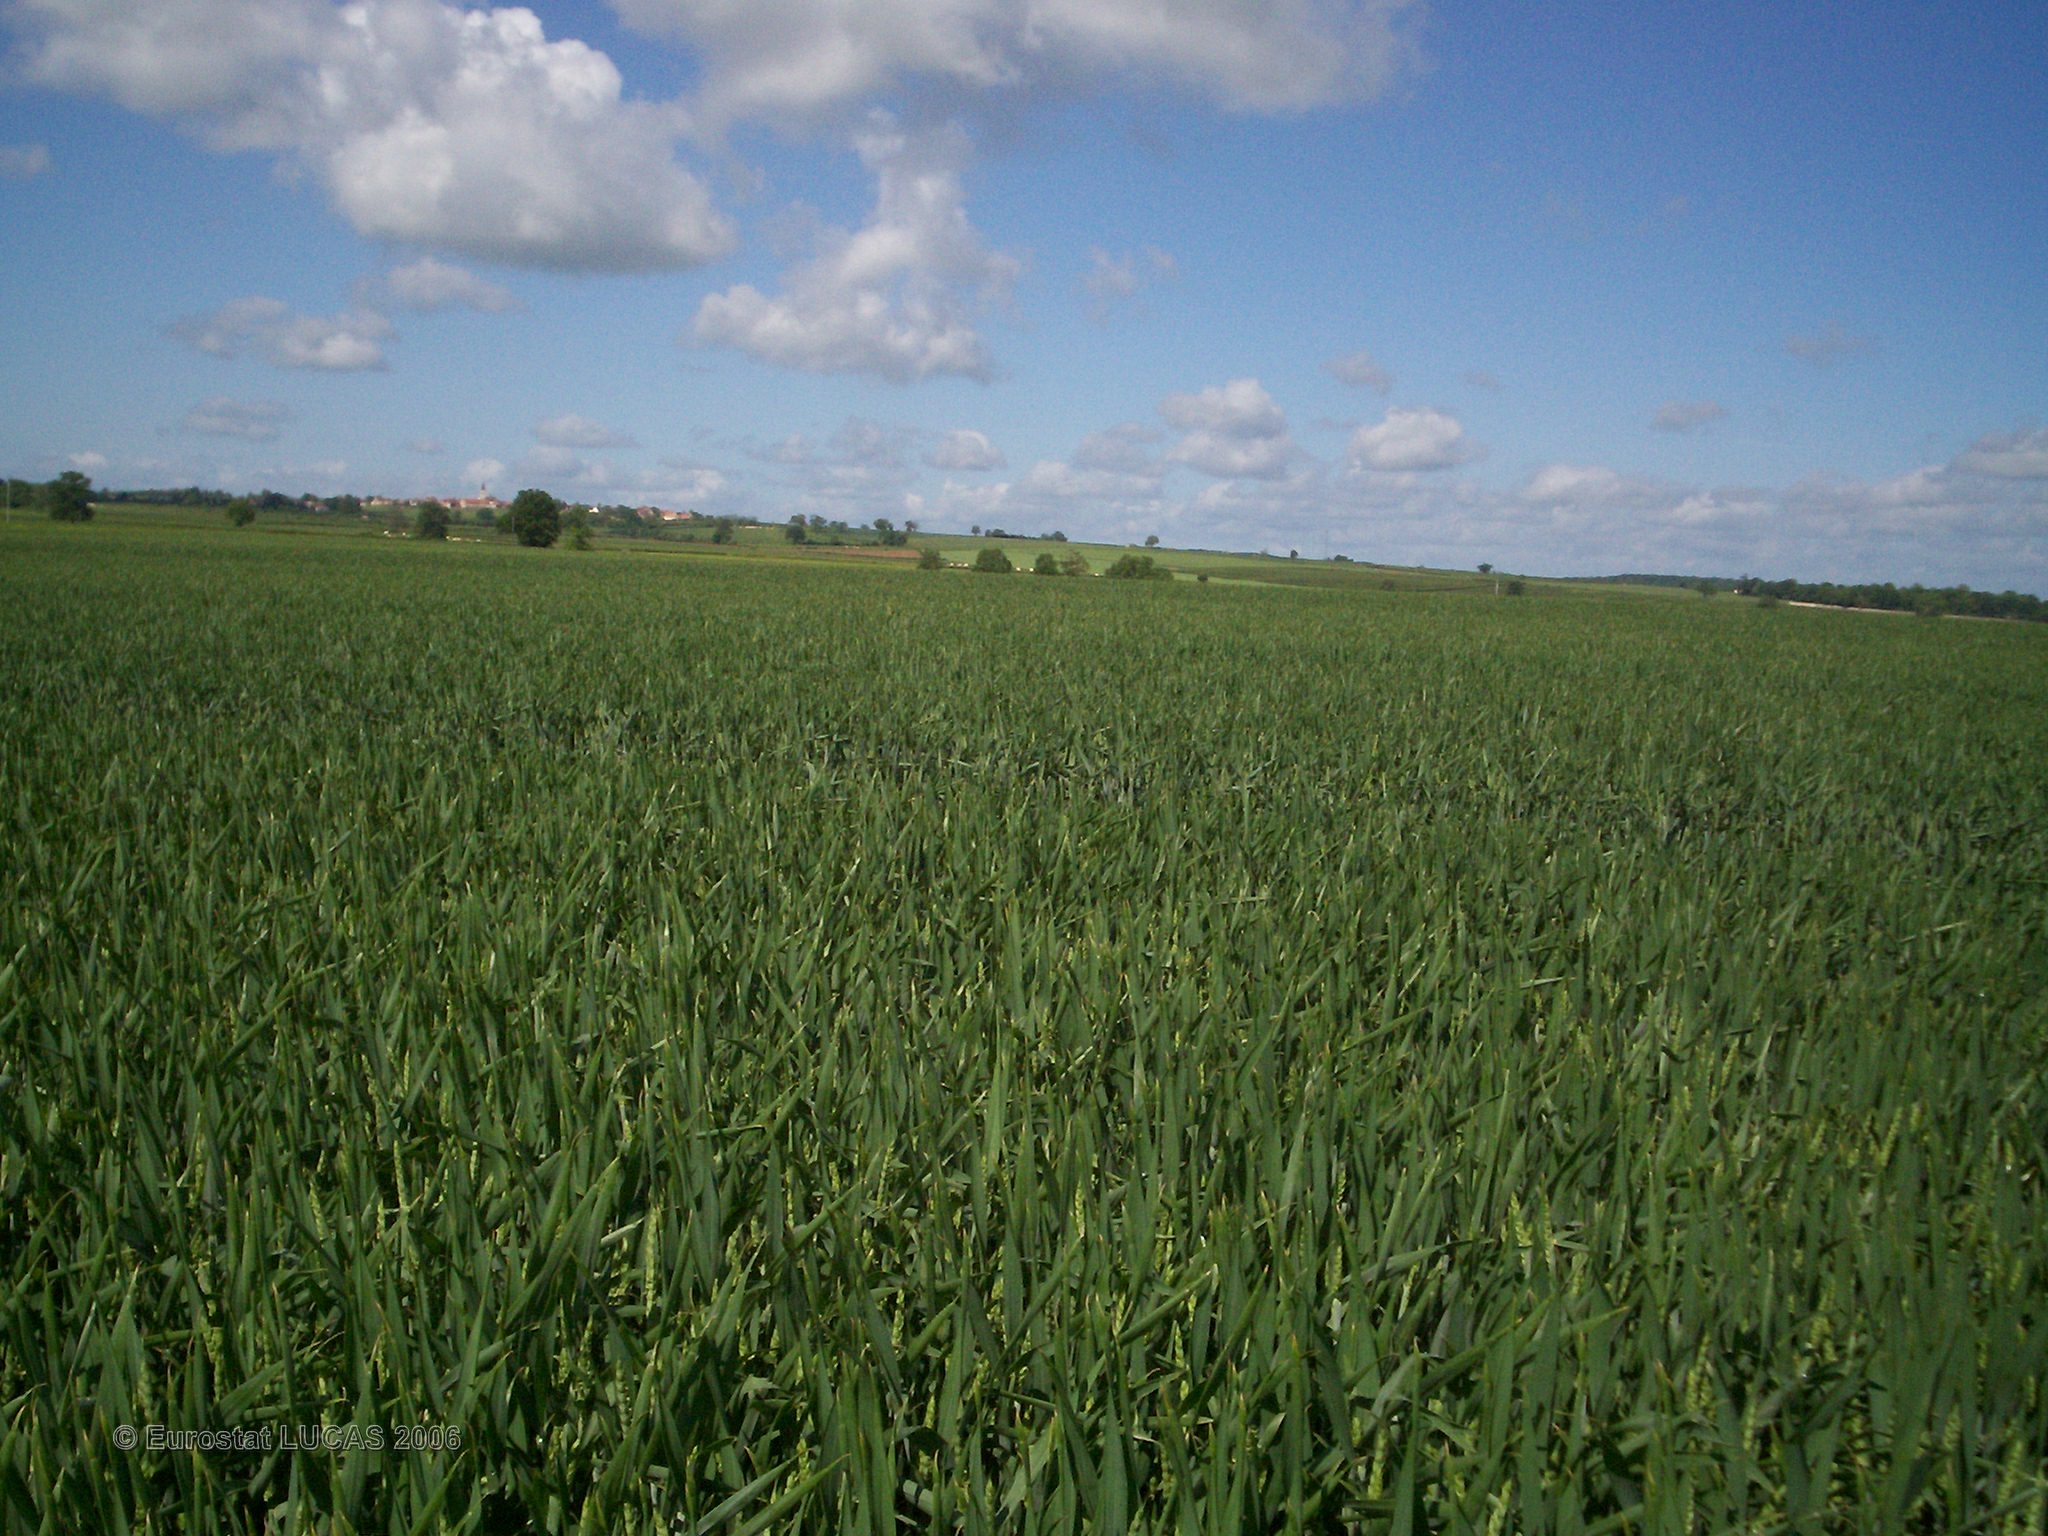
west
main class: Cropland
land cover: Common wheat
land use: Agriculture (excluding fallow land and kitchen gardens)
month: May
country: FR
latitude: 47.4877
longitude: 4.0920
